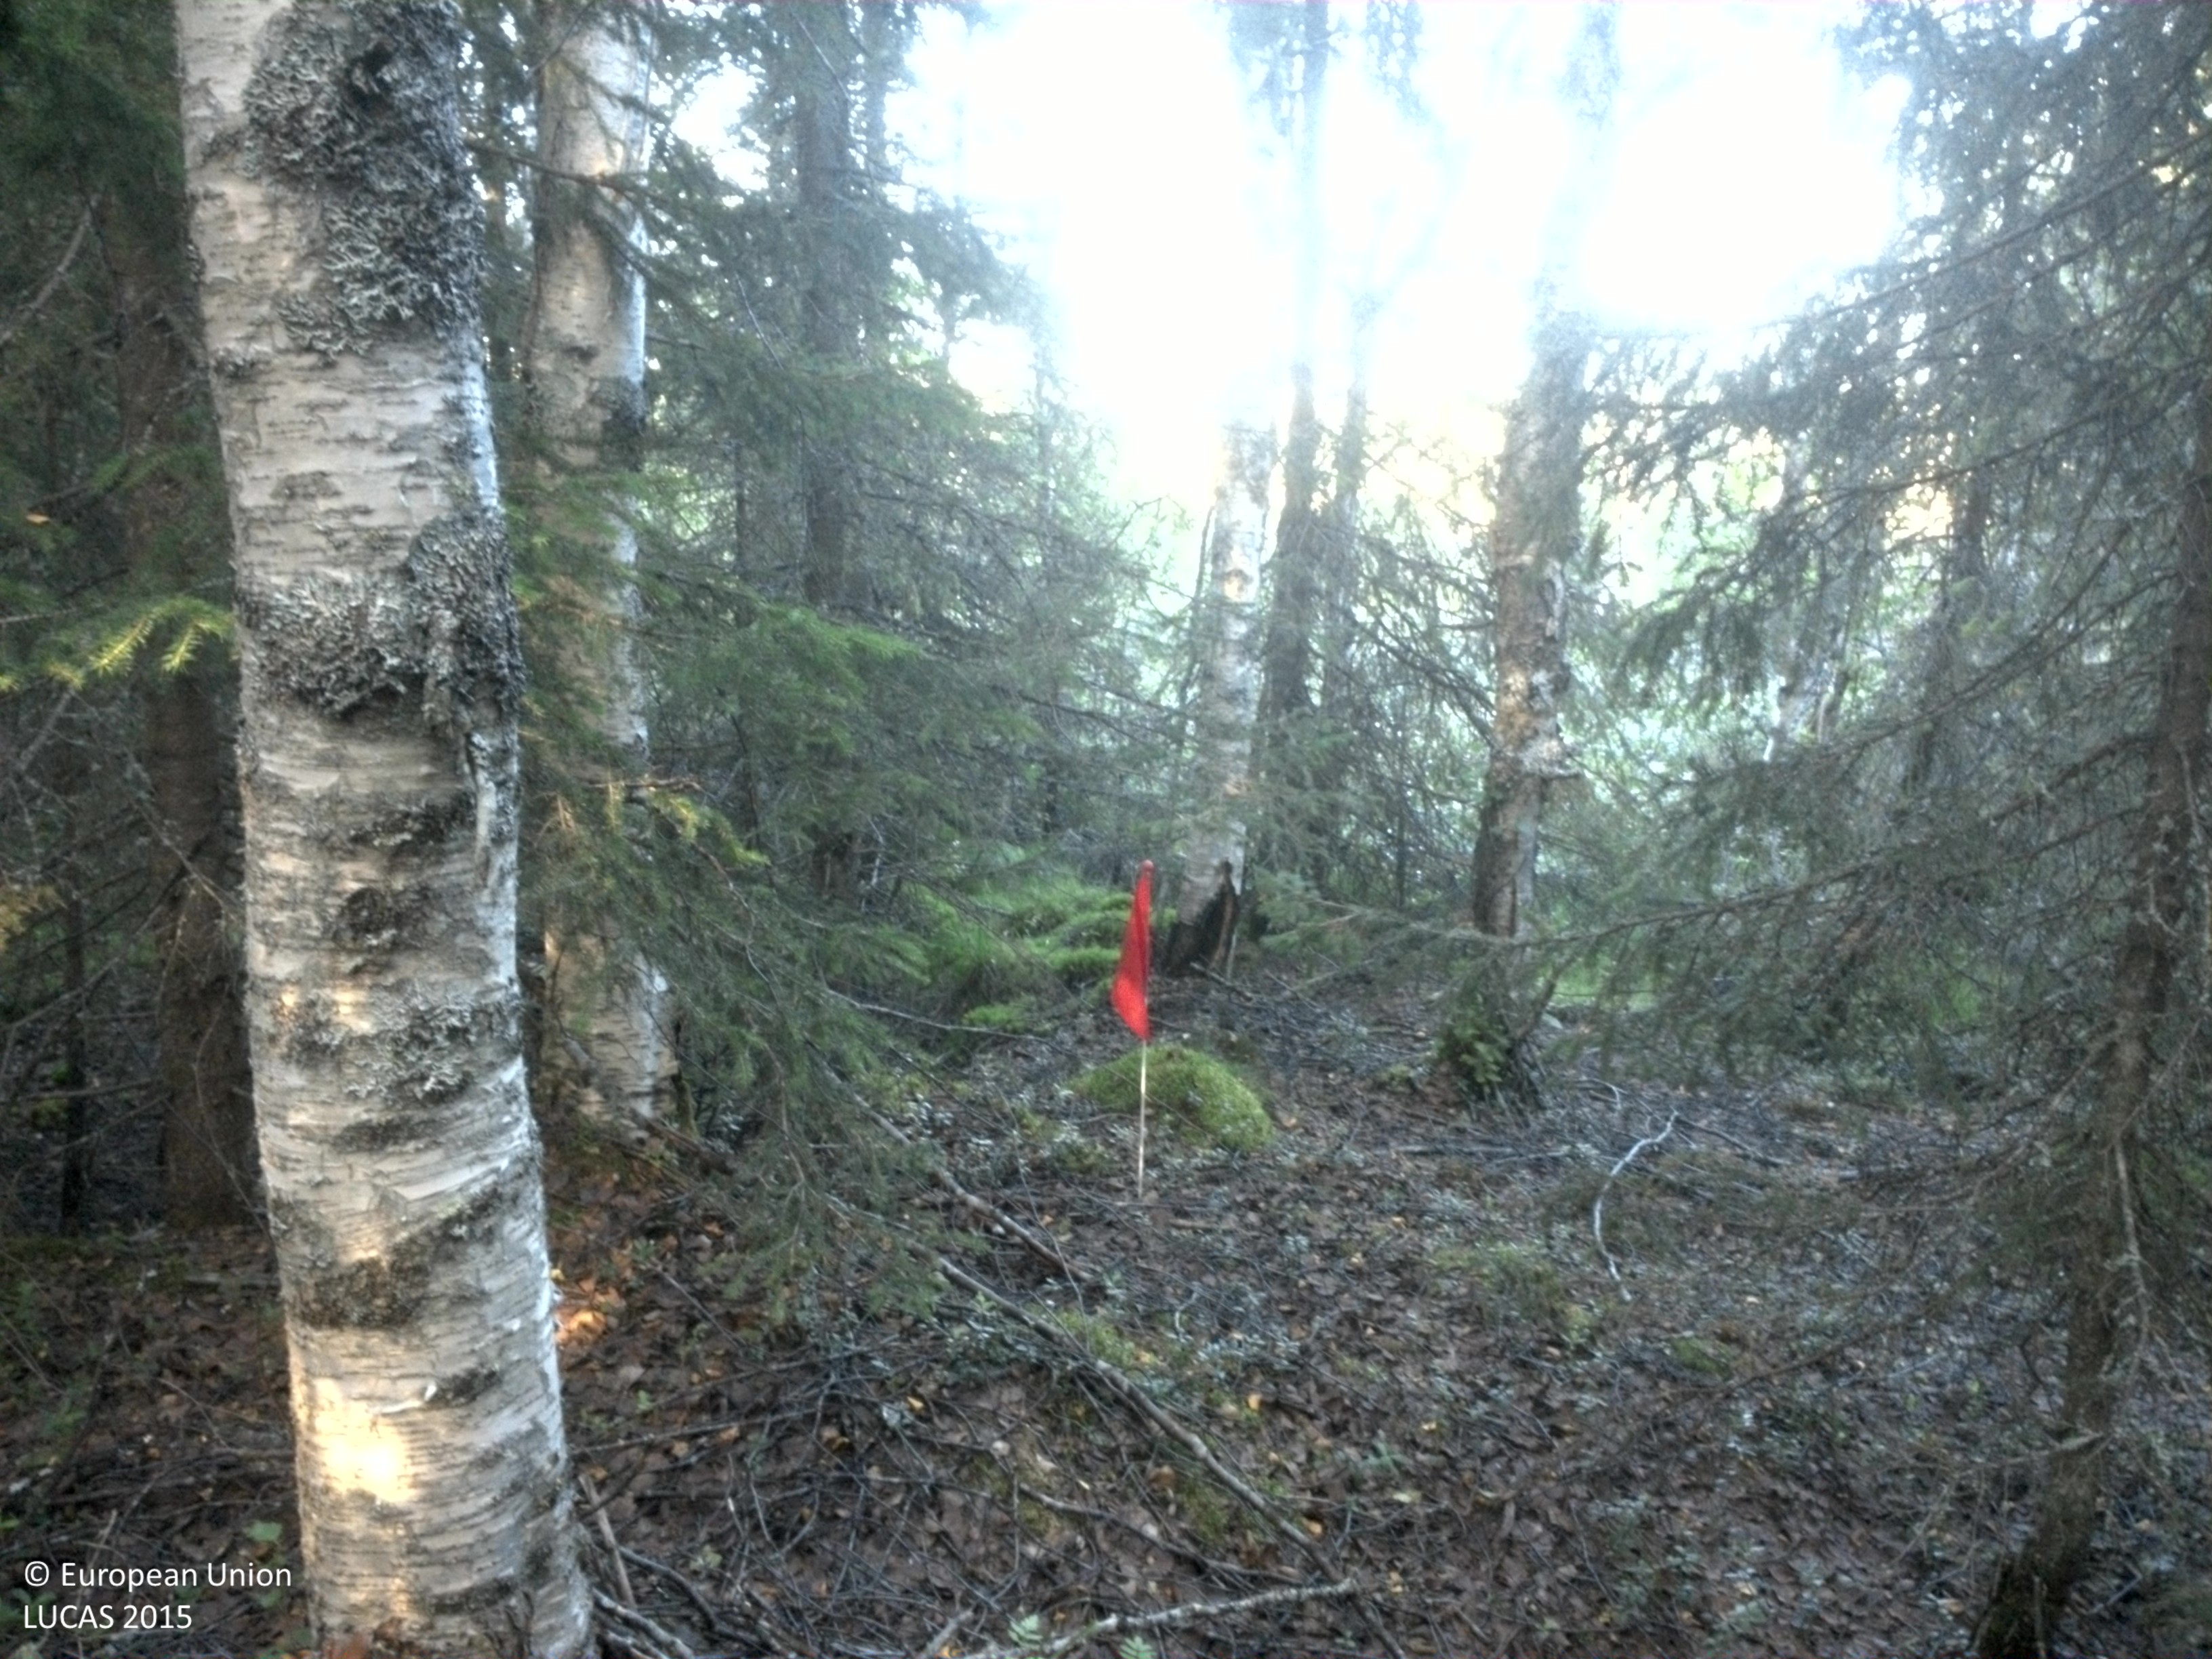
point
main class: Woodland
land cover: Spruce dominated mixed woodland
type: boreal forest
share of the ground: > 75 %
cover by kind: coniferous forest trees 60 %, broadleaved forest trees 20 %, herbaceous plants 20 %
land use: Forestry
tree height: > 5 m
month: August
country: SE
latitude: 64.3931
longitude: 18.4092
